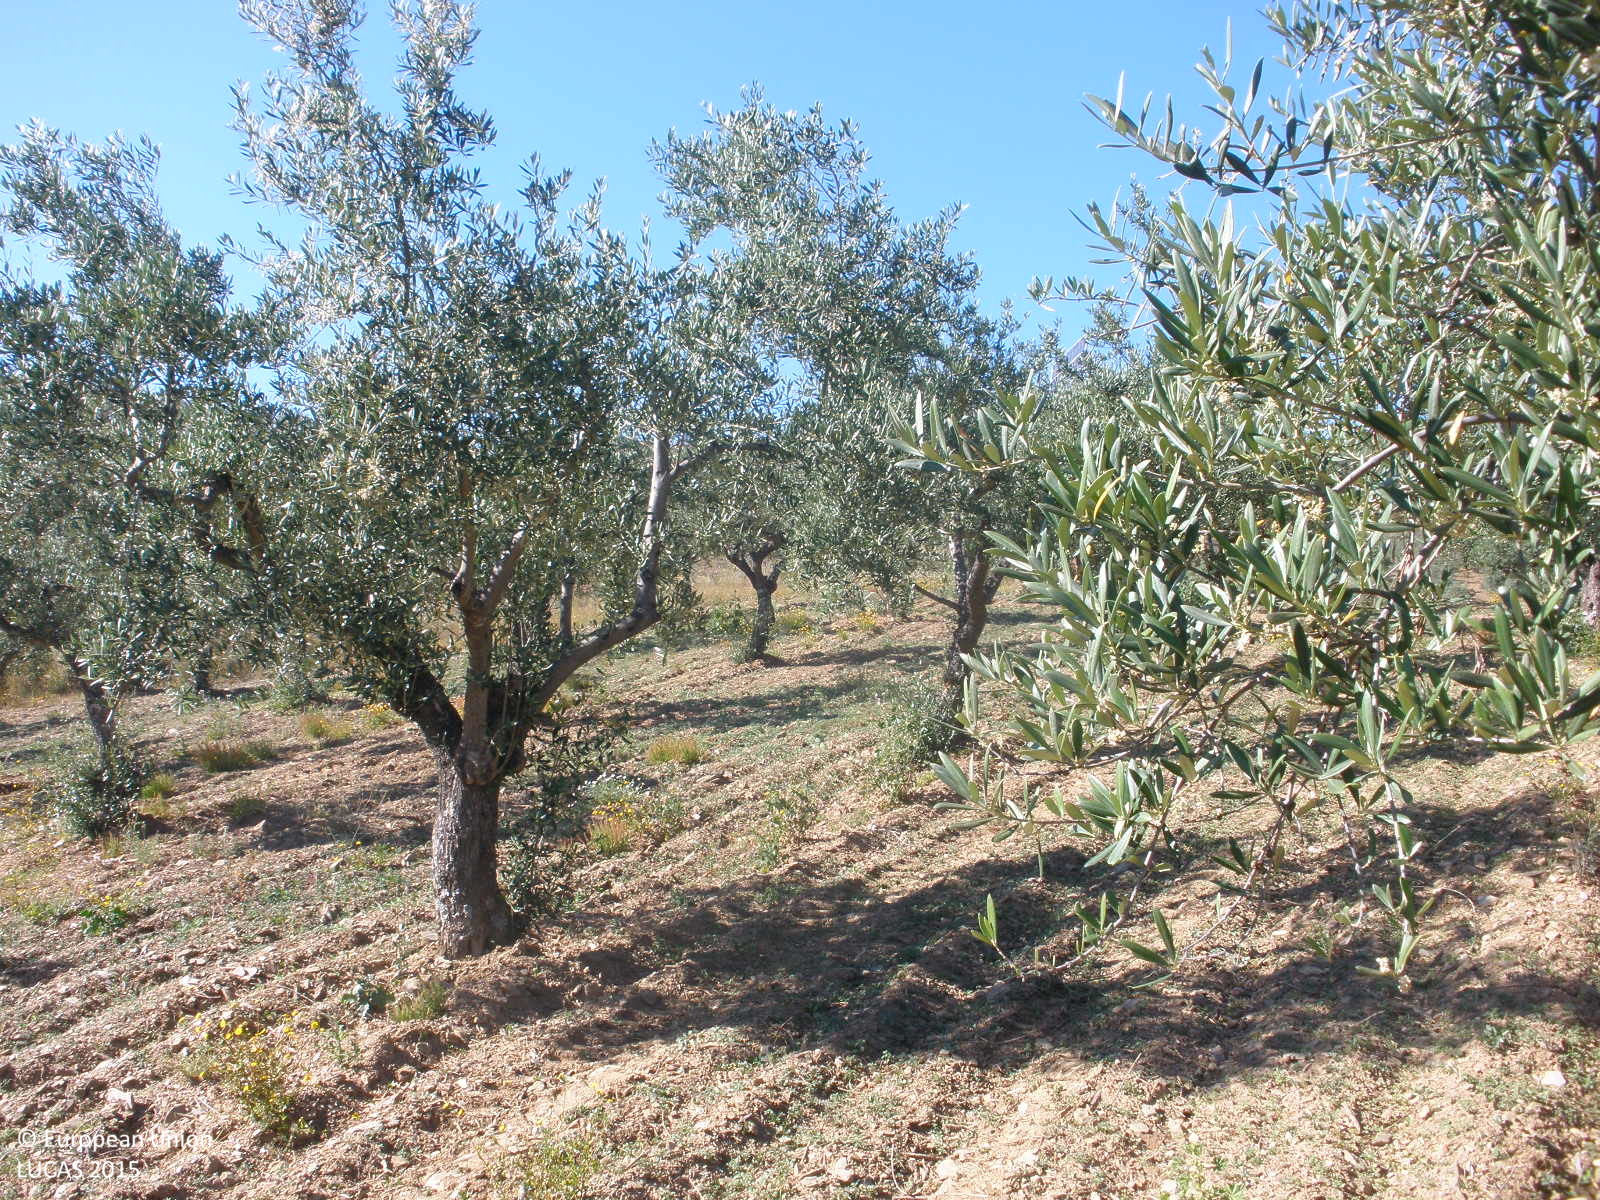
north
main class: Cropland
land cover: Olive groves
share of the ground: 25 - 50 %
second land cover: Spontaneously vegetated surfaces
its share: > 75 %
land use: Agriculture (excluding fallow land and kitchen gardens)
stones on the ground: > 50 %
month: May
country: ES
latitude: 40.2690
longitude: -6.2238
